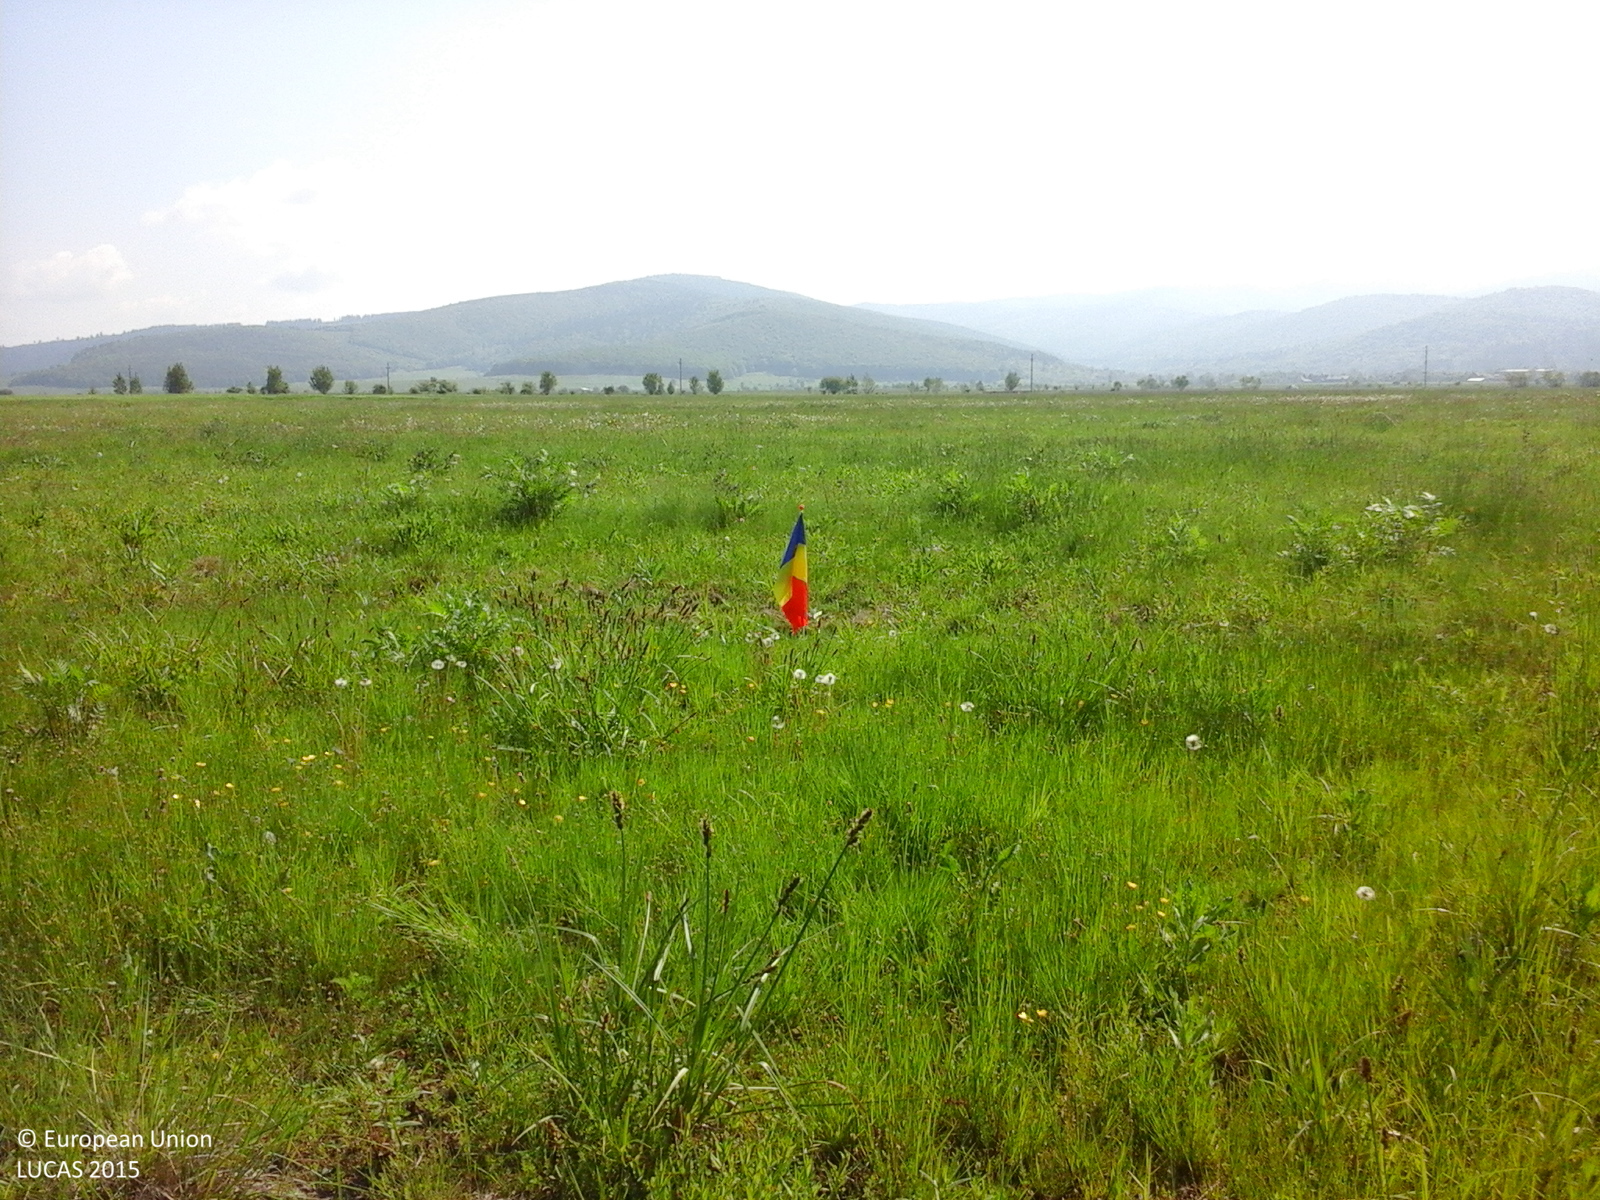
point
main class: Grassland
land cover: Grassland without tree/shrub cover
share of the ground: > 75 %
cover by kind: herbaceous plants 100 %
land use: Agriculture (excluding fallow land and kitchen gardens)
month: May
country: RO
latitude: 45.9001
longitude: 26.1676
